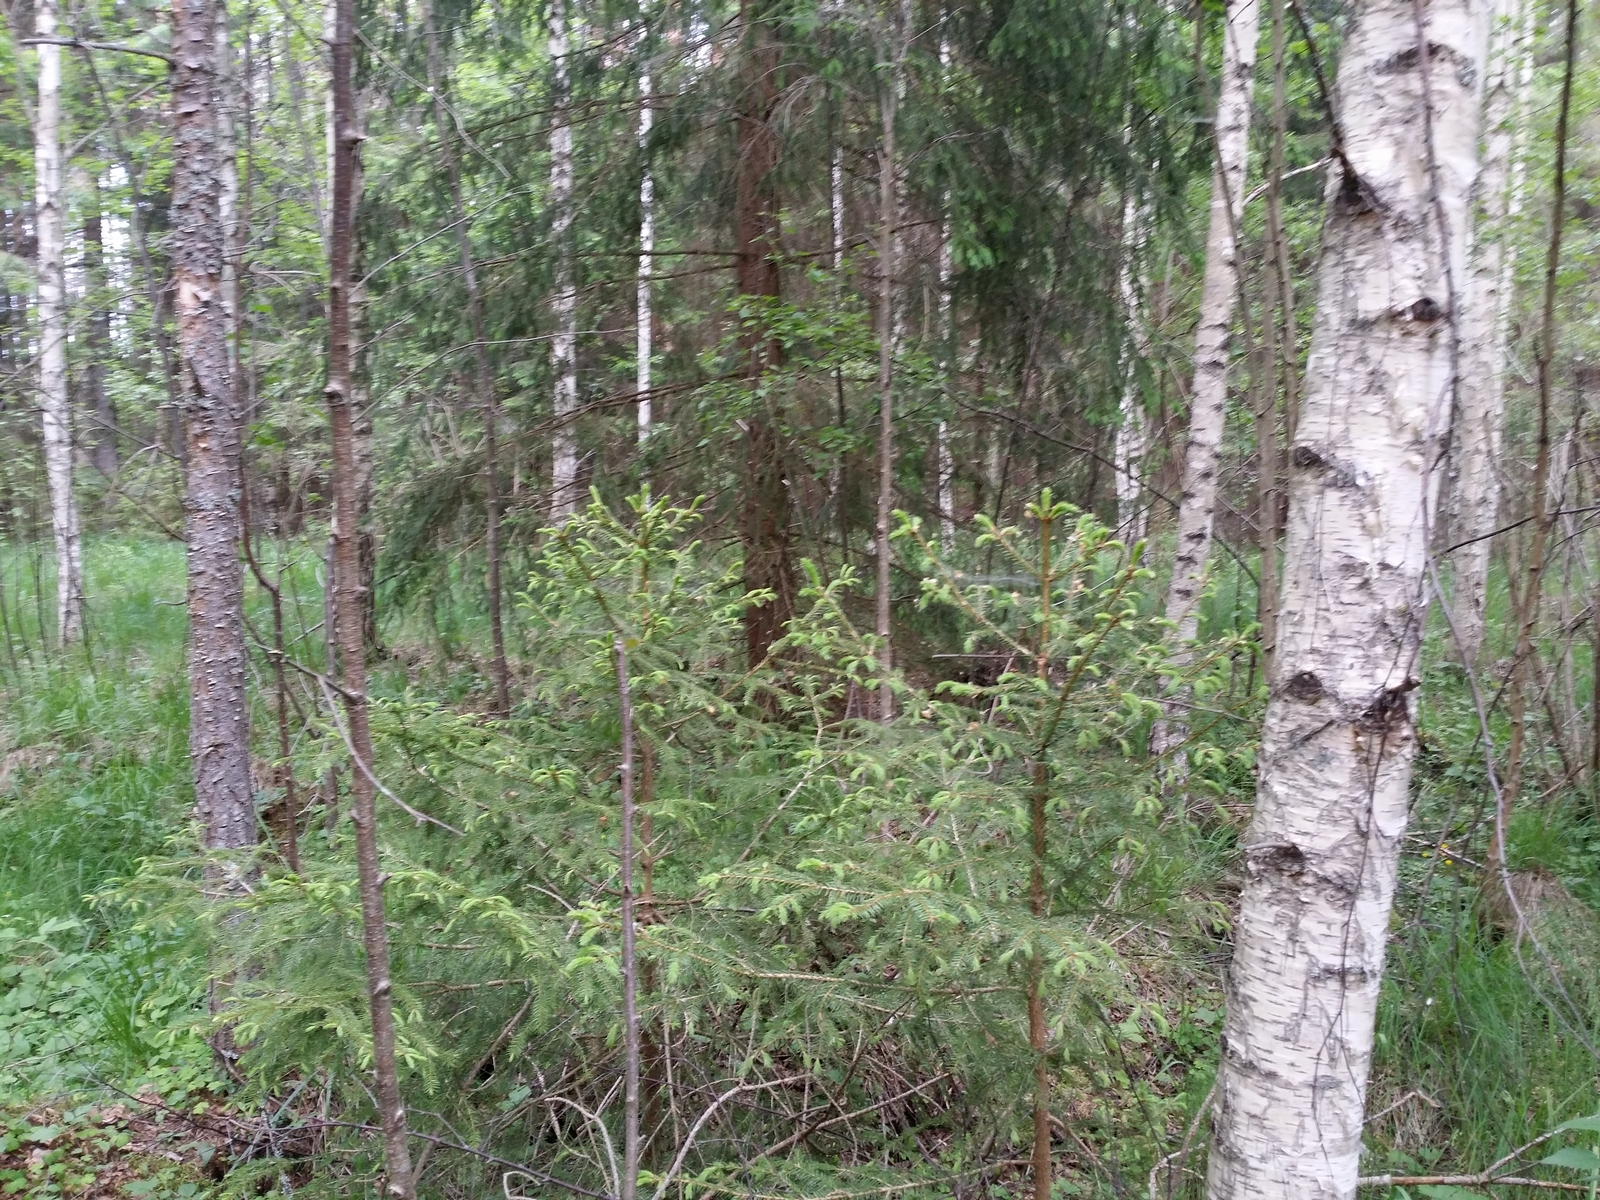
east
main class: Woodland
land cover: Spruce dominated mixed woodland
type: hemiboreal forest and nemoral coniferous forest and mixed broadleaved-coniferous forest
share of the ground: > 75 %
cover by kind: coniferous forest trees 45 %, broadleaved forest trees 35 %, herbaceous plants 10 %, lichens and mosses 10 %
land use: Forestry
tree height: > 5 m
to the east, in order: Spruce dominated mixed woodland; Other coniferous woodland
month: June
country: LV
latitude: 57.3433
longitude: 26.4421
